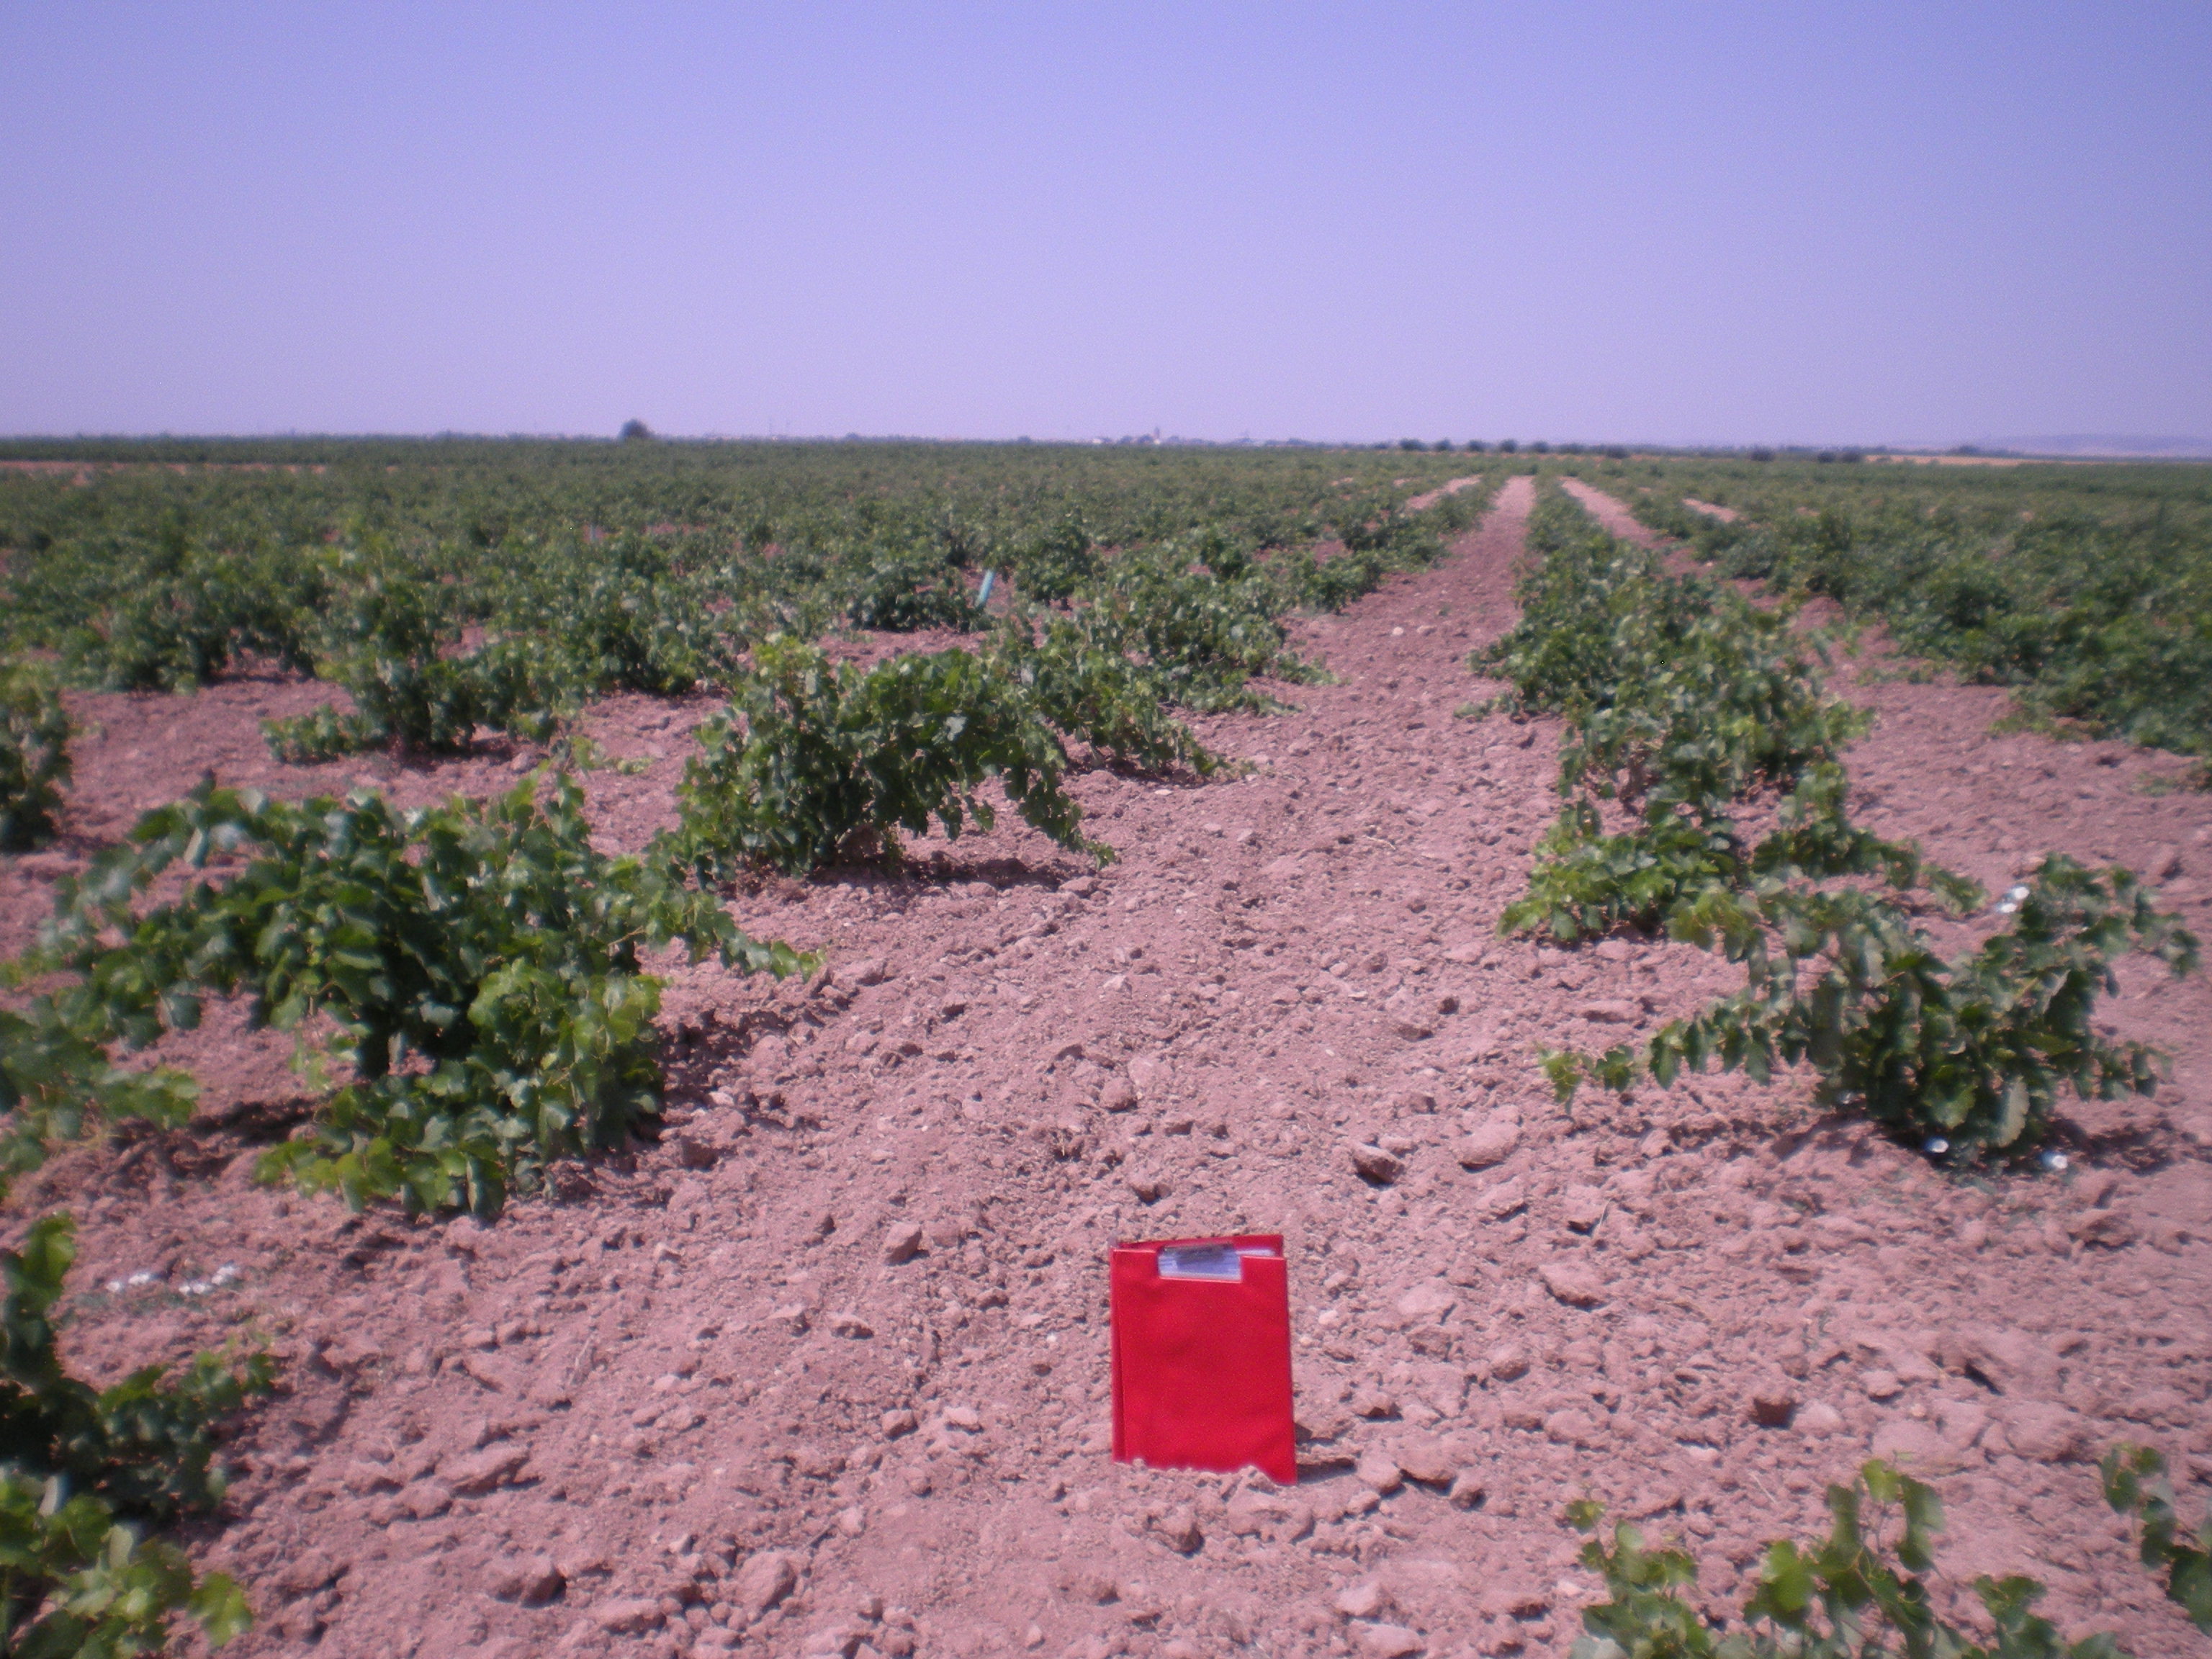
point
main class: Cropland
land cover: Vineyards
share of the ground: 10 - 25 %
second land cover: Other bare soil
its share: > 75 %
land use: Agriculture (excluding fallow land and kitchen gardens)
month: June
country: ES
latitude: 39.6310
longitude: -3.1745
